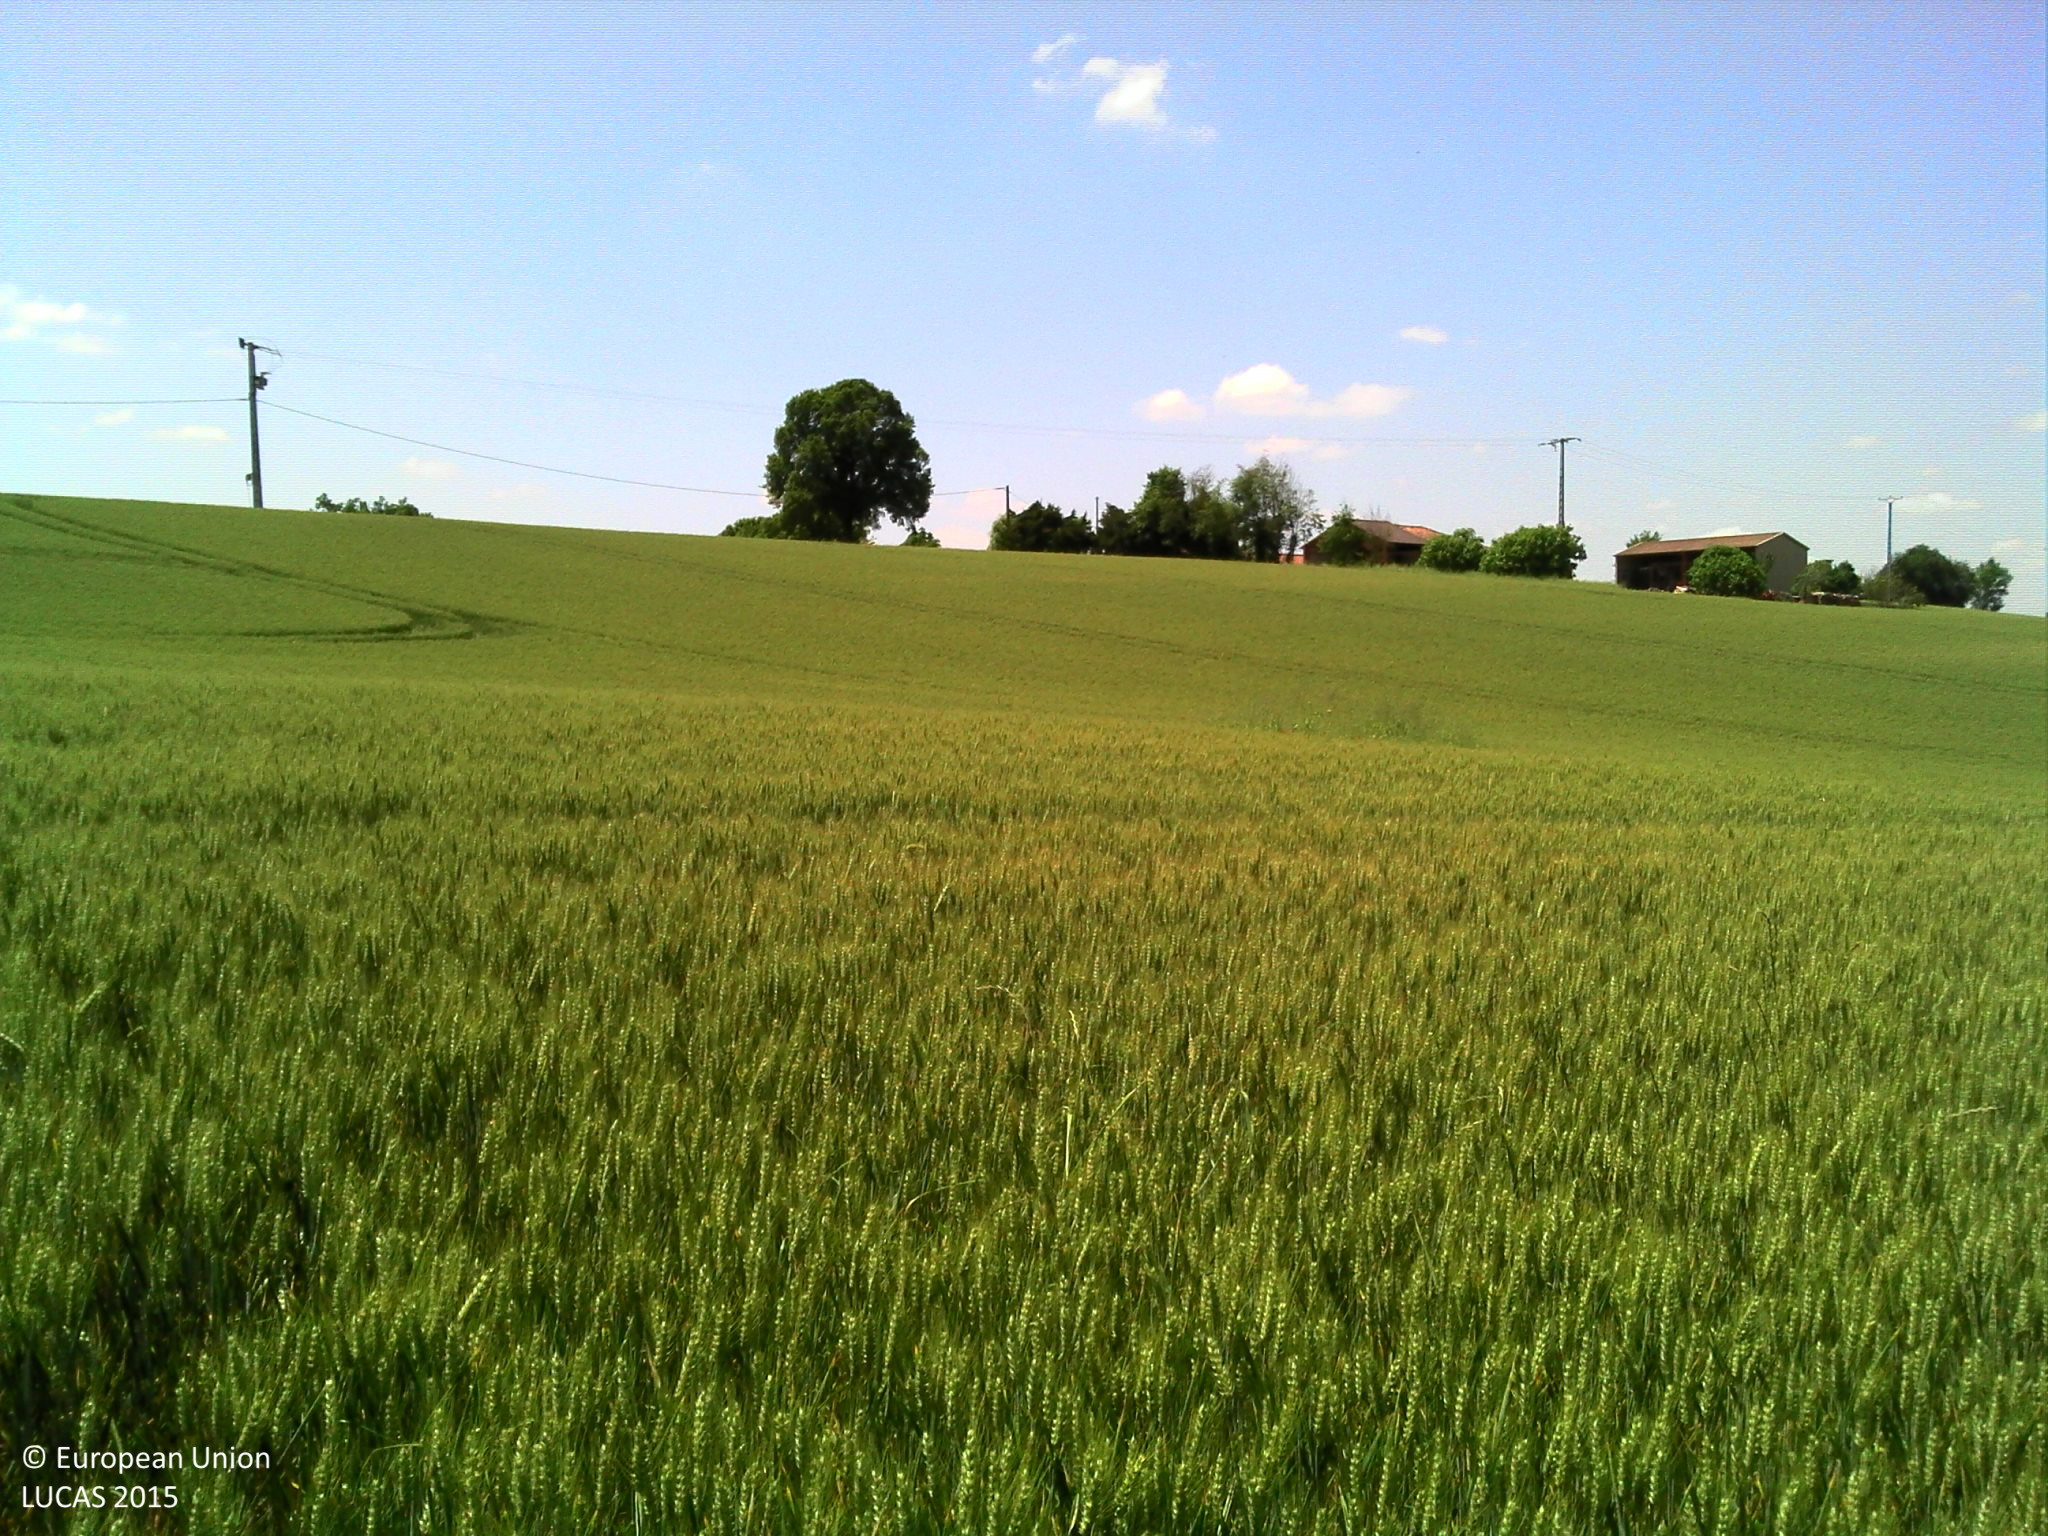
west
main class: Cropland
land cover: Common wheat
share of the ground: > 75 %
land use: Agriculture (excluding fallow land and kitchen gardens)
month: June
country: FR
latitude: 43.5937
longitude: 0.7711
